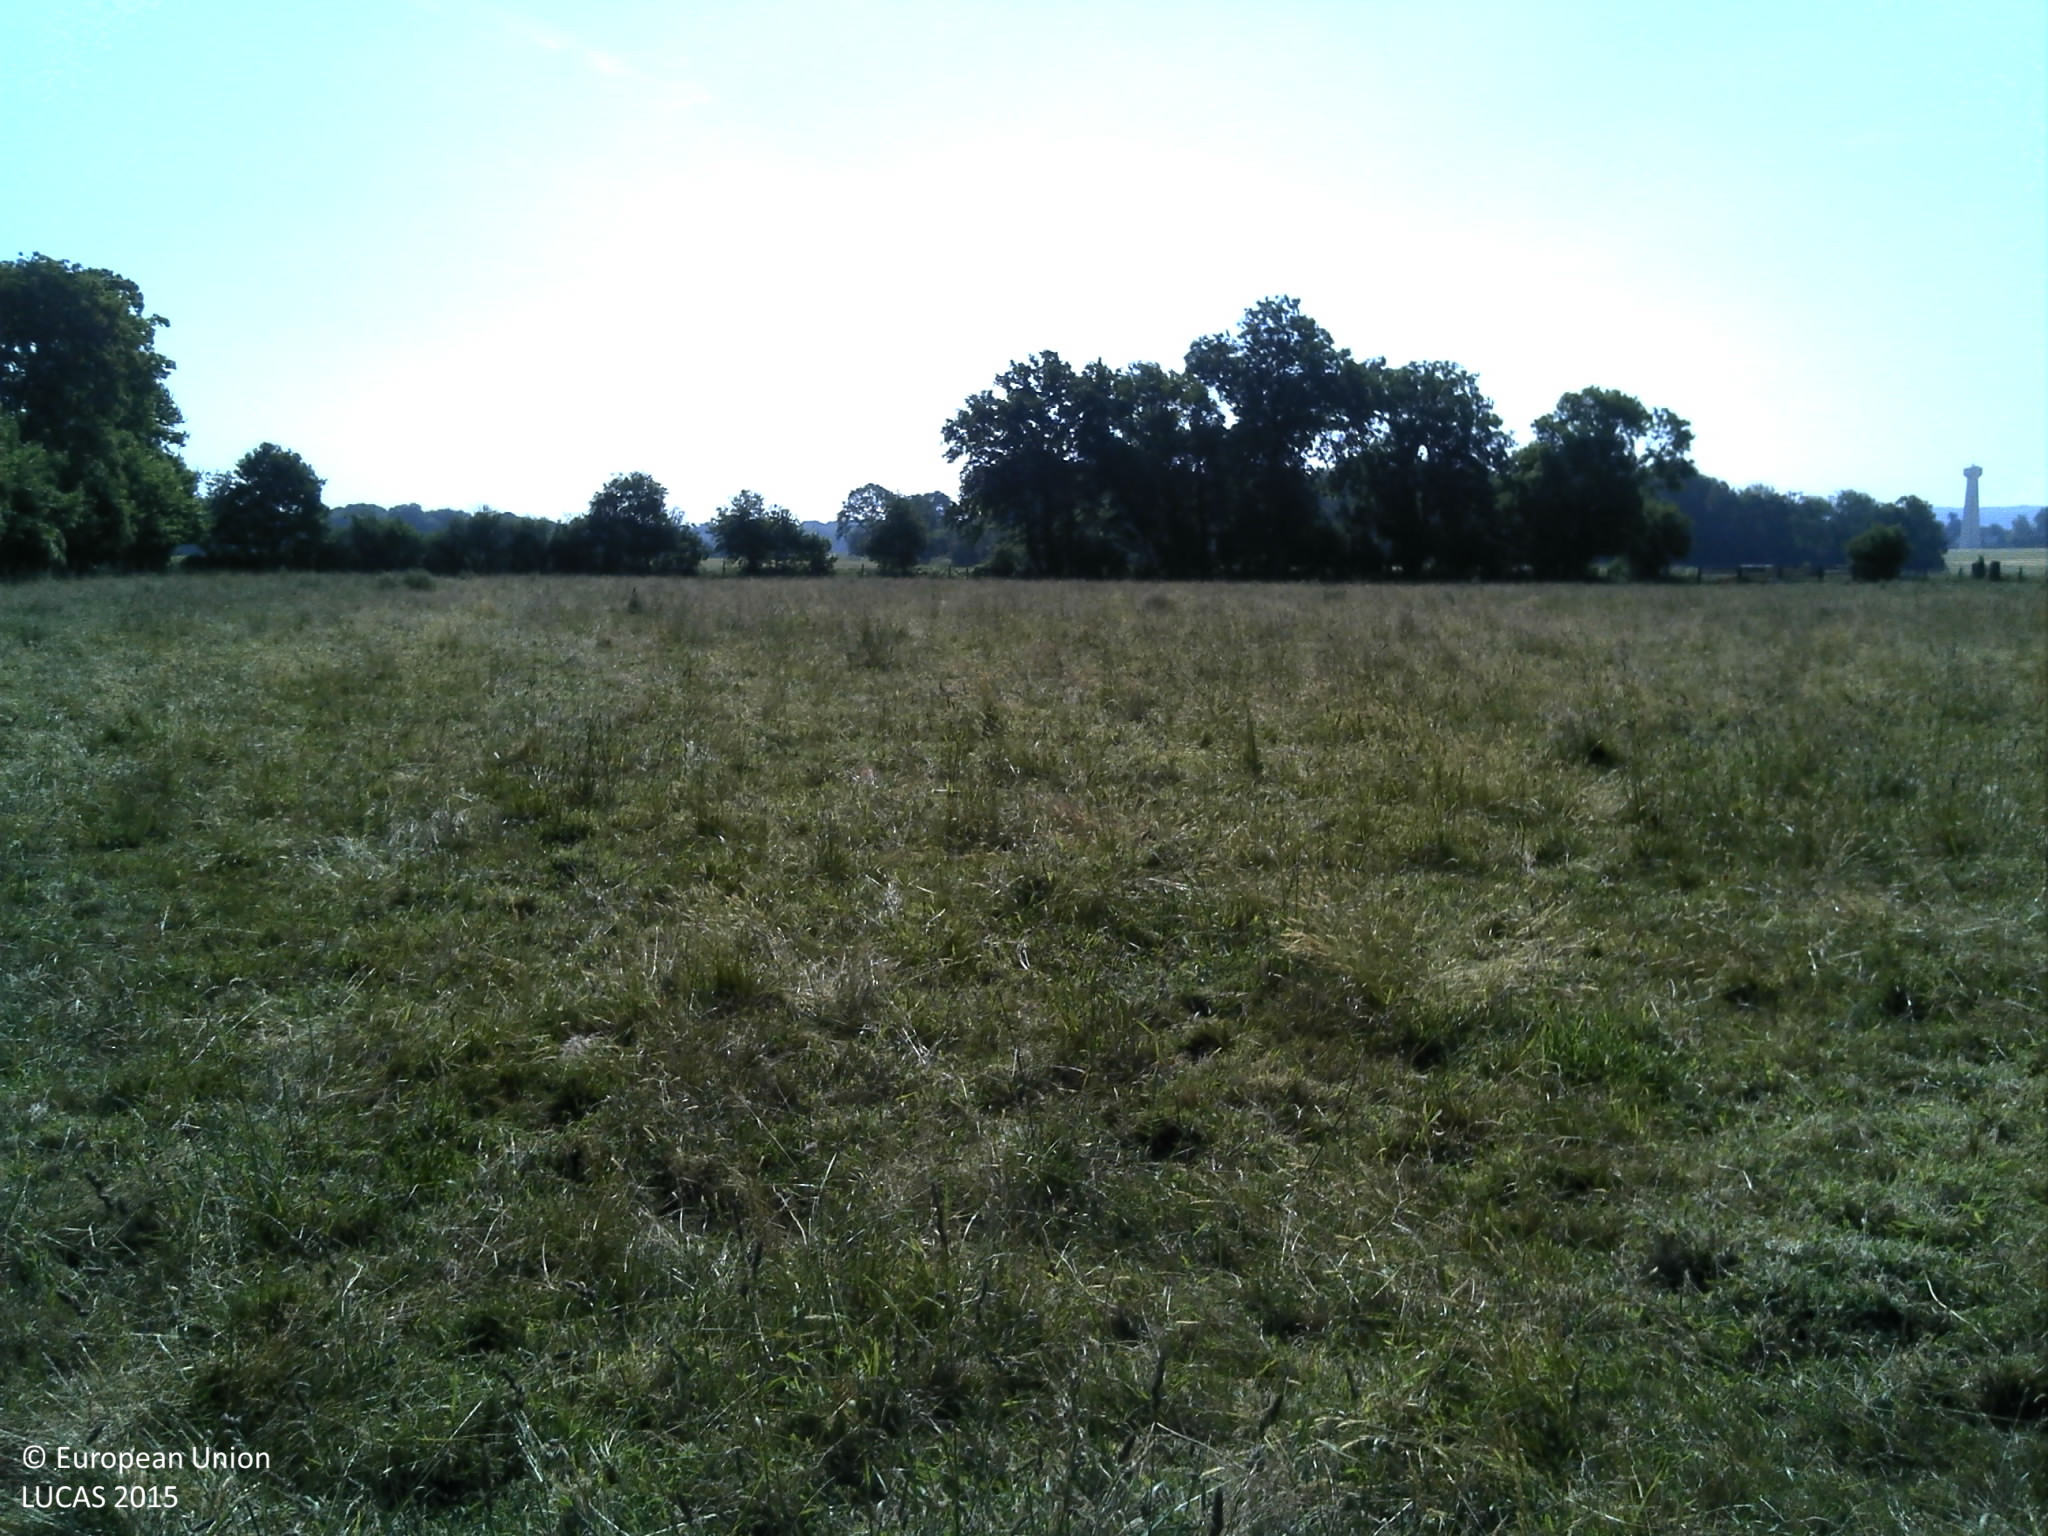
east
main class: Grassland
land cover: Grassland without tree/shrub cover
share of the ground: > 75 %
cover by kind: herbaceous plants 100 %
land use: Agriculture (excluding fallow land and kitchen gardens)
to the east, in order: Grassland without tree/shrub cover; Fences; Abandoned hedges; Common wheat; Durum wheat; Common wheat; Durum wheat; Common wheat; Durum wheat
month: June
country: FR
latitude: 49.4696
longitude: 0.6045
